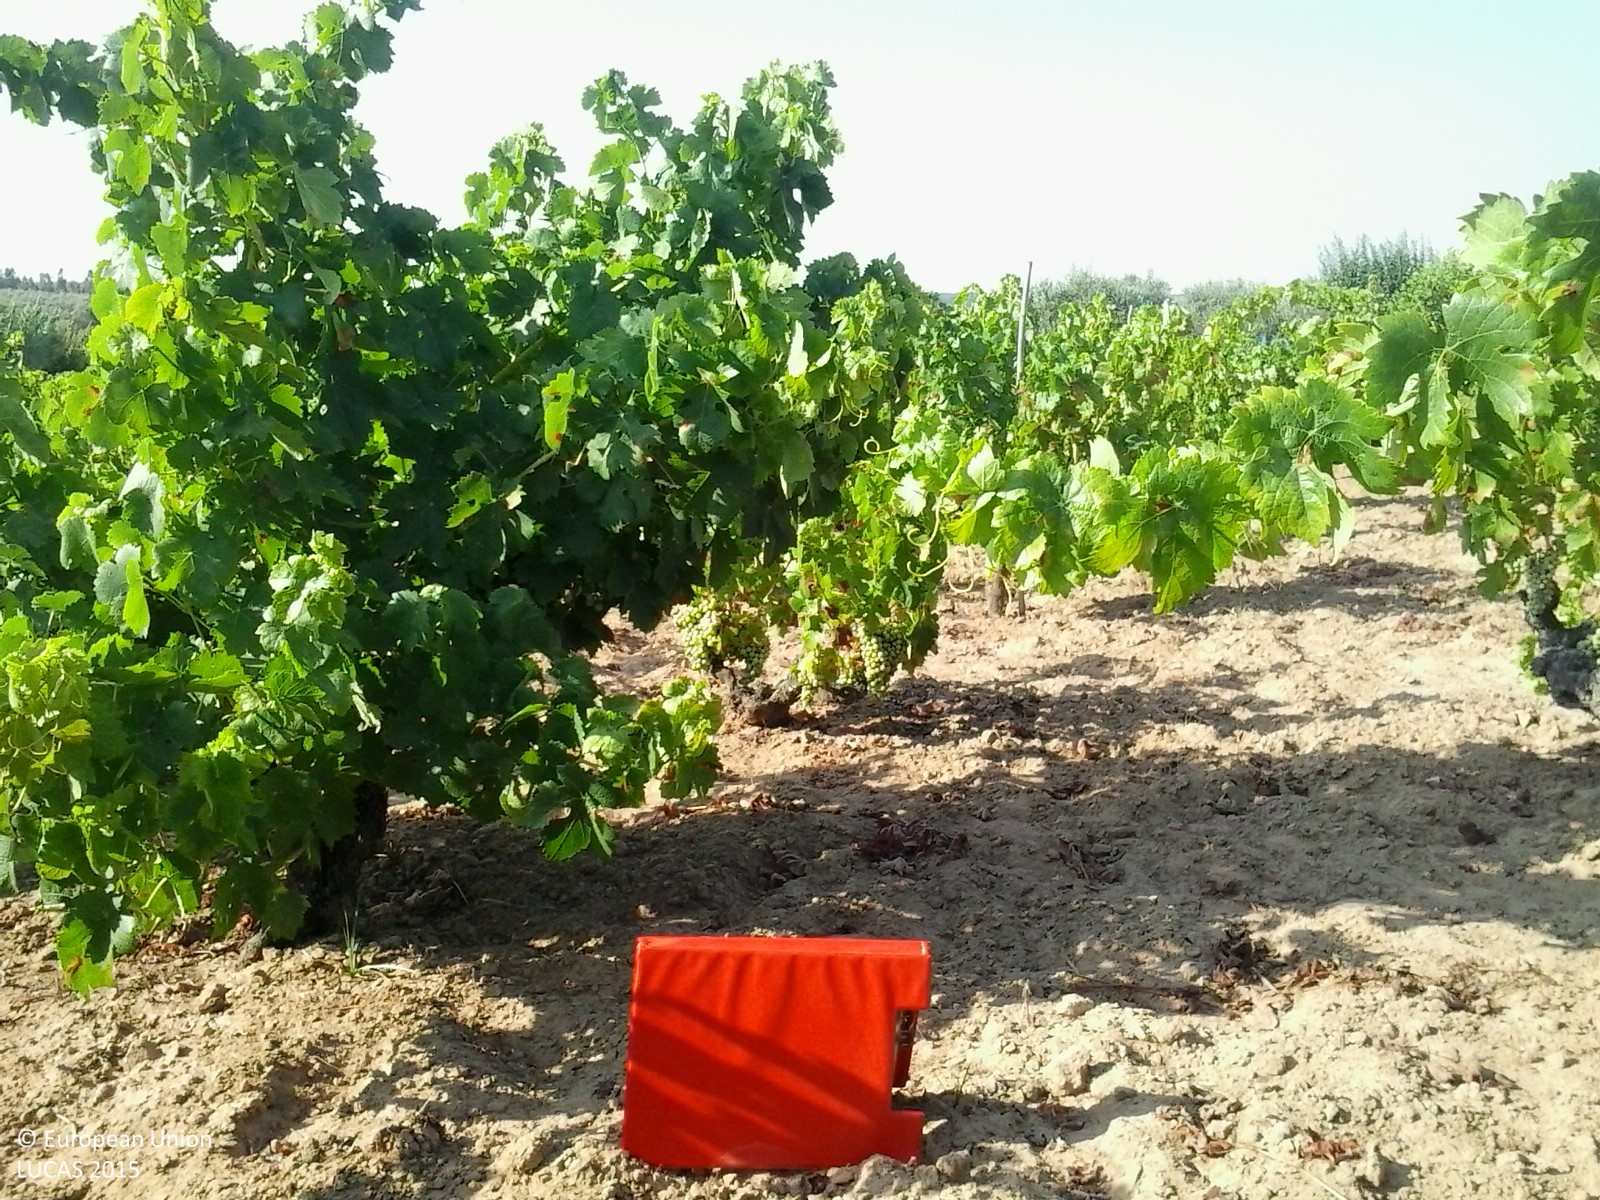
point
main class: Cropland
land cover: Vineyards
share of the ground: 10 - 25 %
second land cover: Other bare soil
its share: > 75 %
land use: Agriculture (excluding fallow land and kitchen gardens)
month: June
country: ES
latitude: 37.3727
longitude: -6.4619
